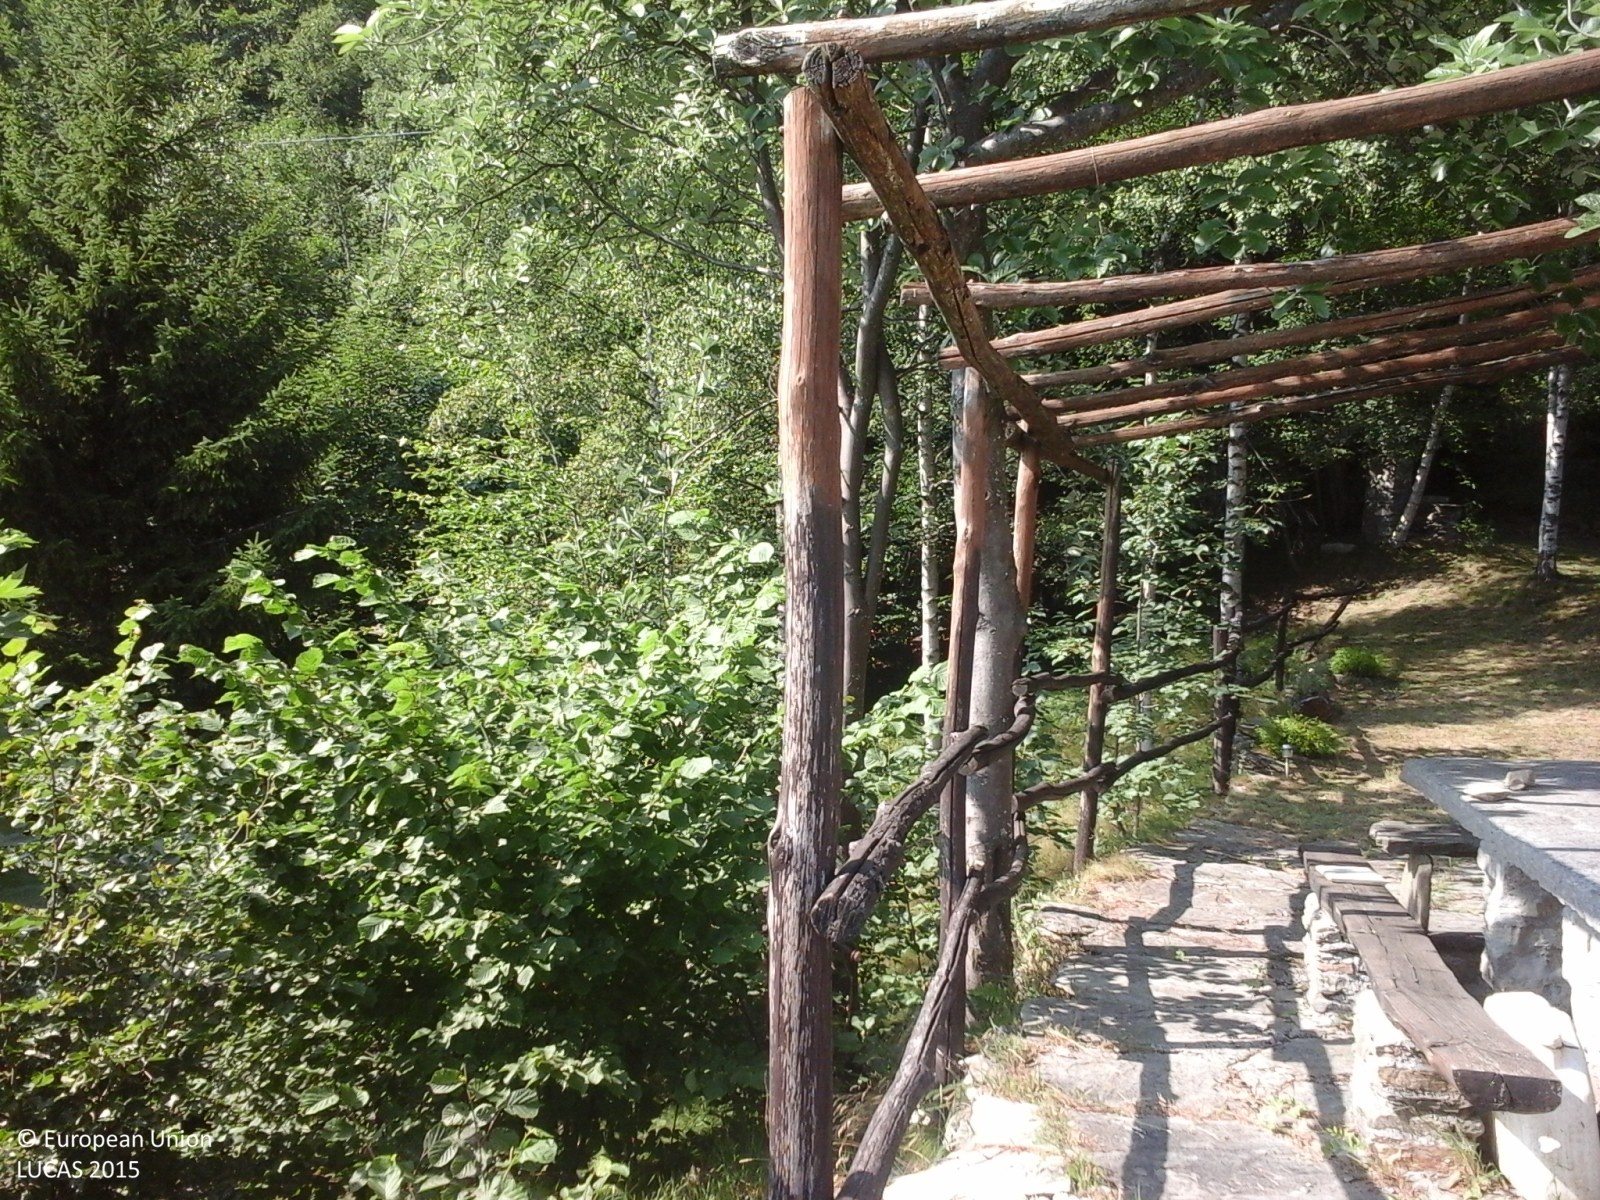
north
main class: Woodland
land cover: Broadleaved woodland
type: mesophytic deciduous forest
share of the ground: > 75 %
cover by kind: broadleaved forest trees 100 %
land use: Semi-natural and natural areas not in use
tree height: > 5 m
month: July
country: IT
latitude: 44.8723
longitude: 7.2076
